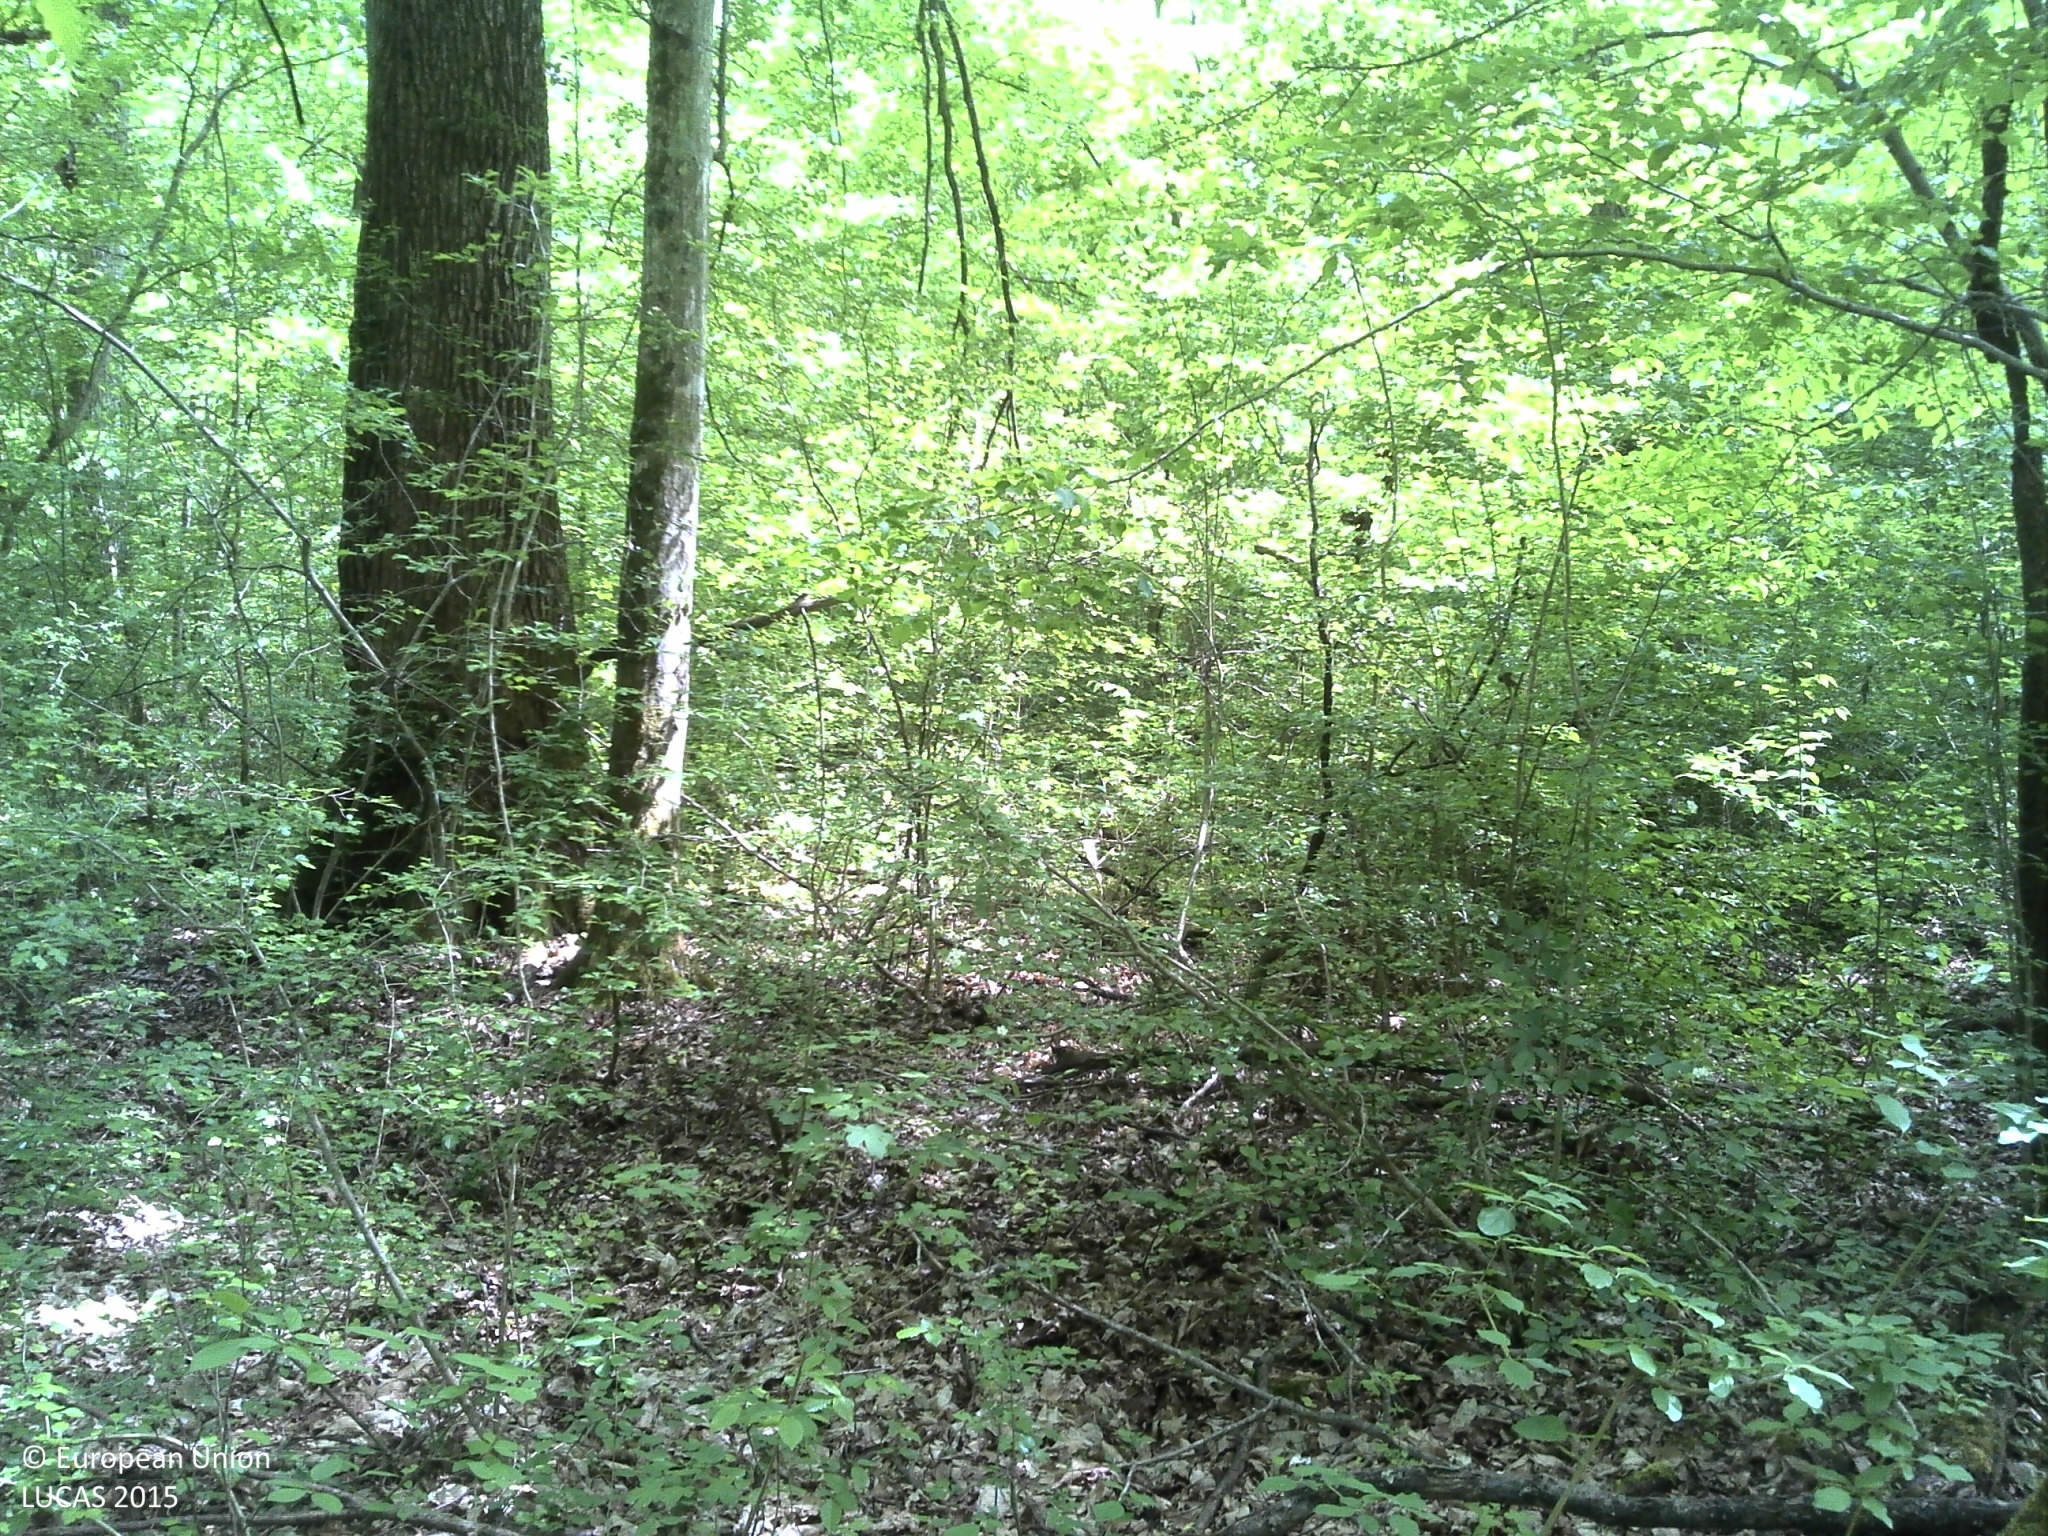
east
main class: Woodland
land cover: Broadleaved woodland
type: mesophytic deciduous forest
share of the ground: > 75 %
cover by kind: broadleaved forest trees 100 %
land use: Forestry
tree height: > 5 m
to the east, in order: Broadleaved woodland
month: April
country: HR
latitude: 45.0769
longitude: 18.8605
